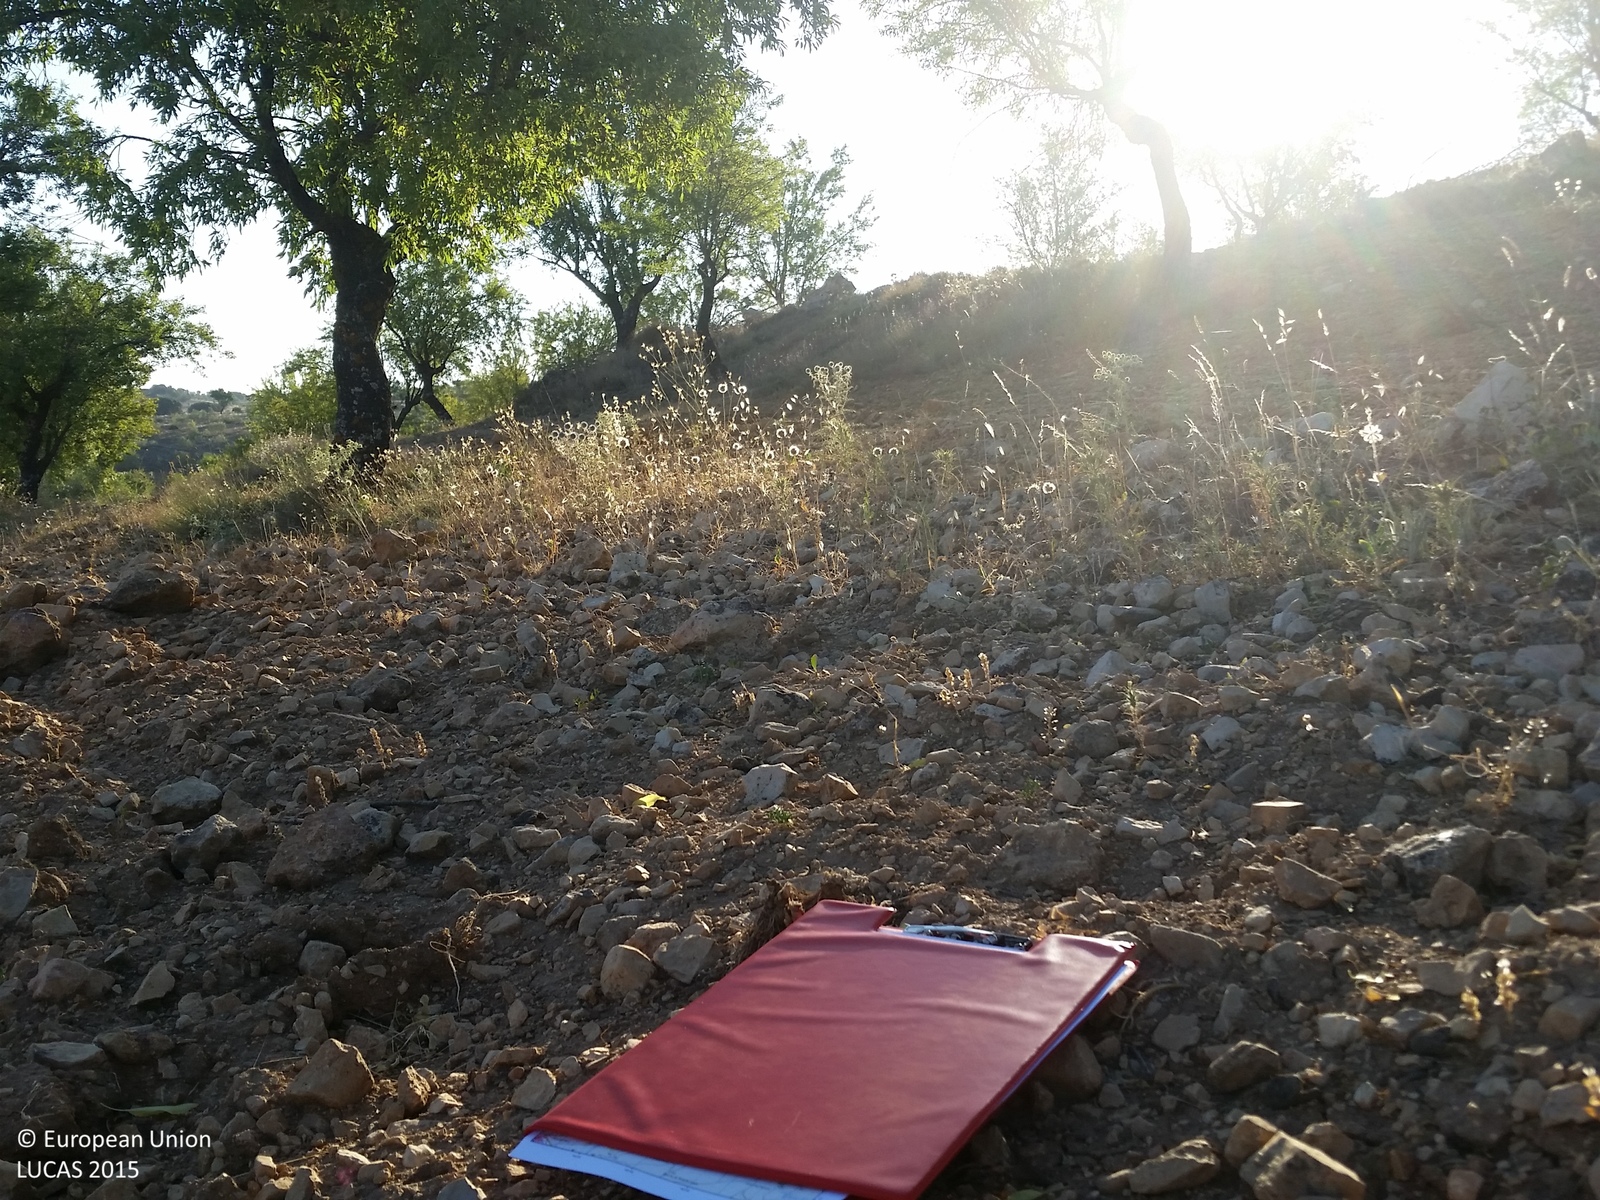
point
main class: Cropland
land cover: Nuts trees
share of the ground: > 75 %
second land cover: Grassland without tree/shrub cover
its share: 25 - 50 %
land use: Agriculture (excluding fallow land and kitchen gardens)
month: July
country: ES
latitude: 38.9669
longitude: -2.5278
